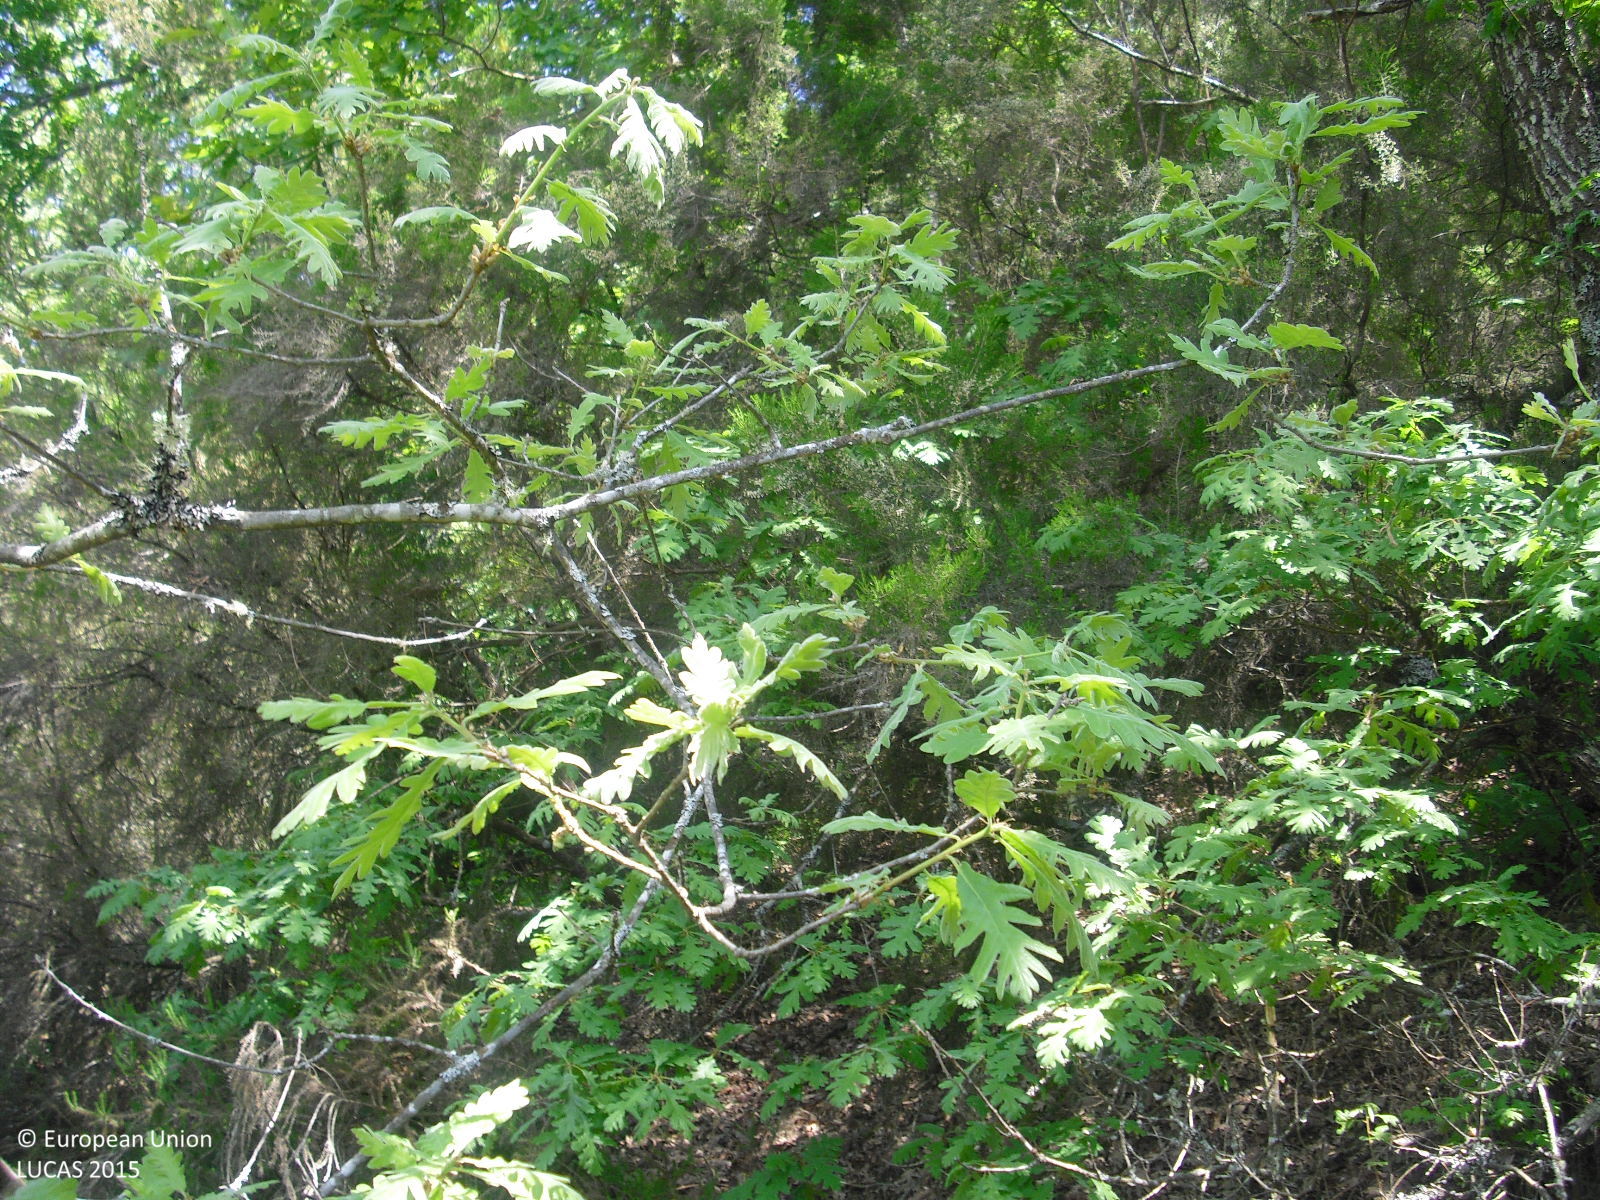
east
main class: Woodland
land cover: Broadleaved woodland
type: acidophilous oak and oak-birch forest
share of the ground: > 75 %
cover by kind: broadleaved forest trees 80 %, shrubs 20 %
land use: Semi-natural and natural areas not in use
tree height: > 5 m
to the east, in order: Broadleaved woodland; Ditches and canals; Broadleaved woodland; Dry stone walls; Broadleaved woodland; Dry stone walls; Broadleaved woodland; Dry stone walls; Broadleaved woodland; Rivers and streams; Dry stone walls; Broadleaved woodland; Dry stone walls; Rivers and streams; Broadleaved woodland
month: May
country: ES
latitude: 42.1318
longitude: -7.5965
